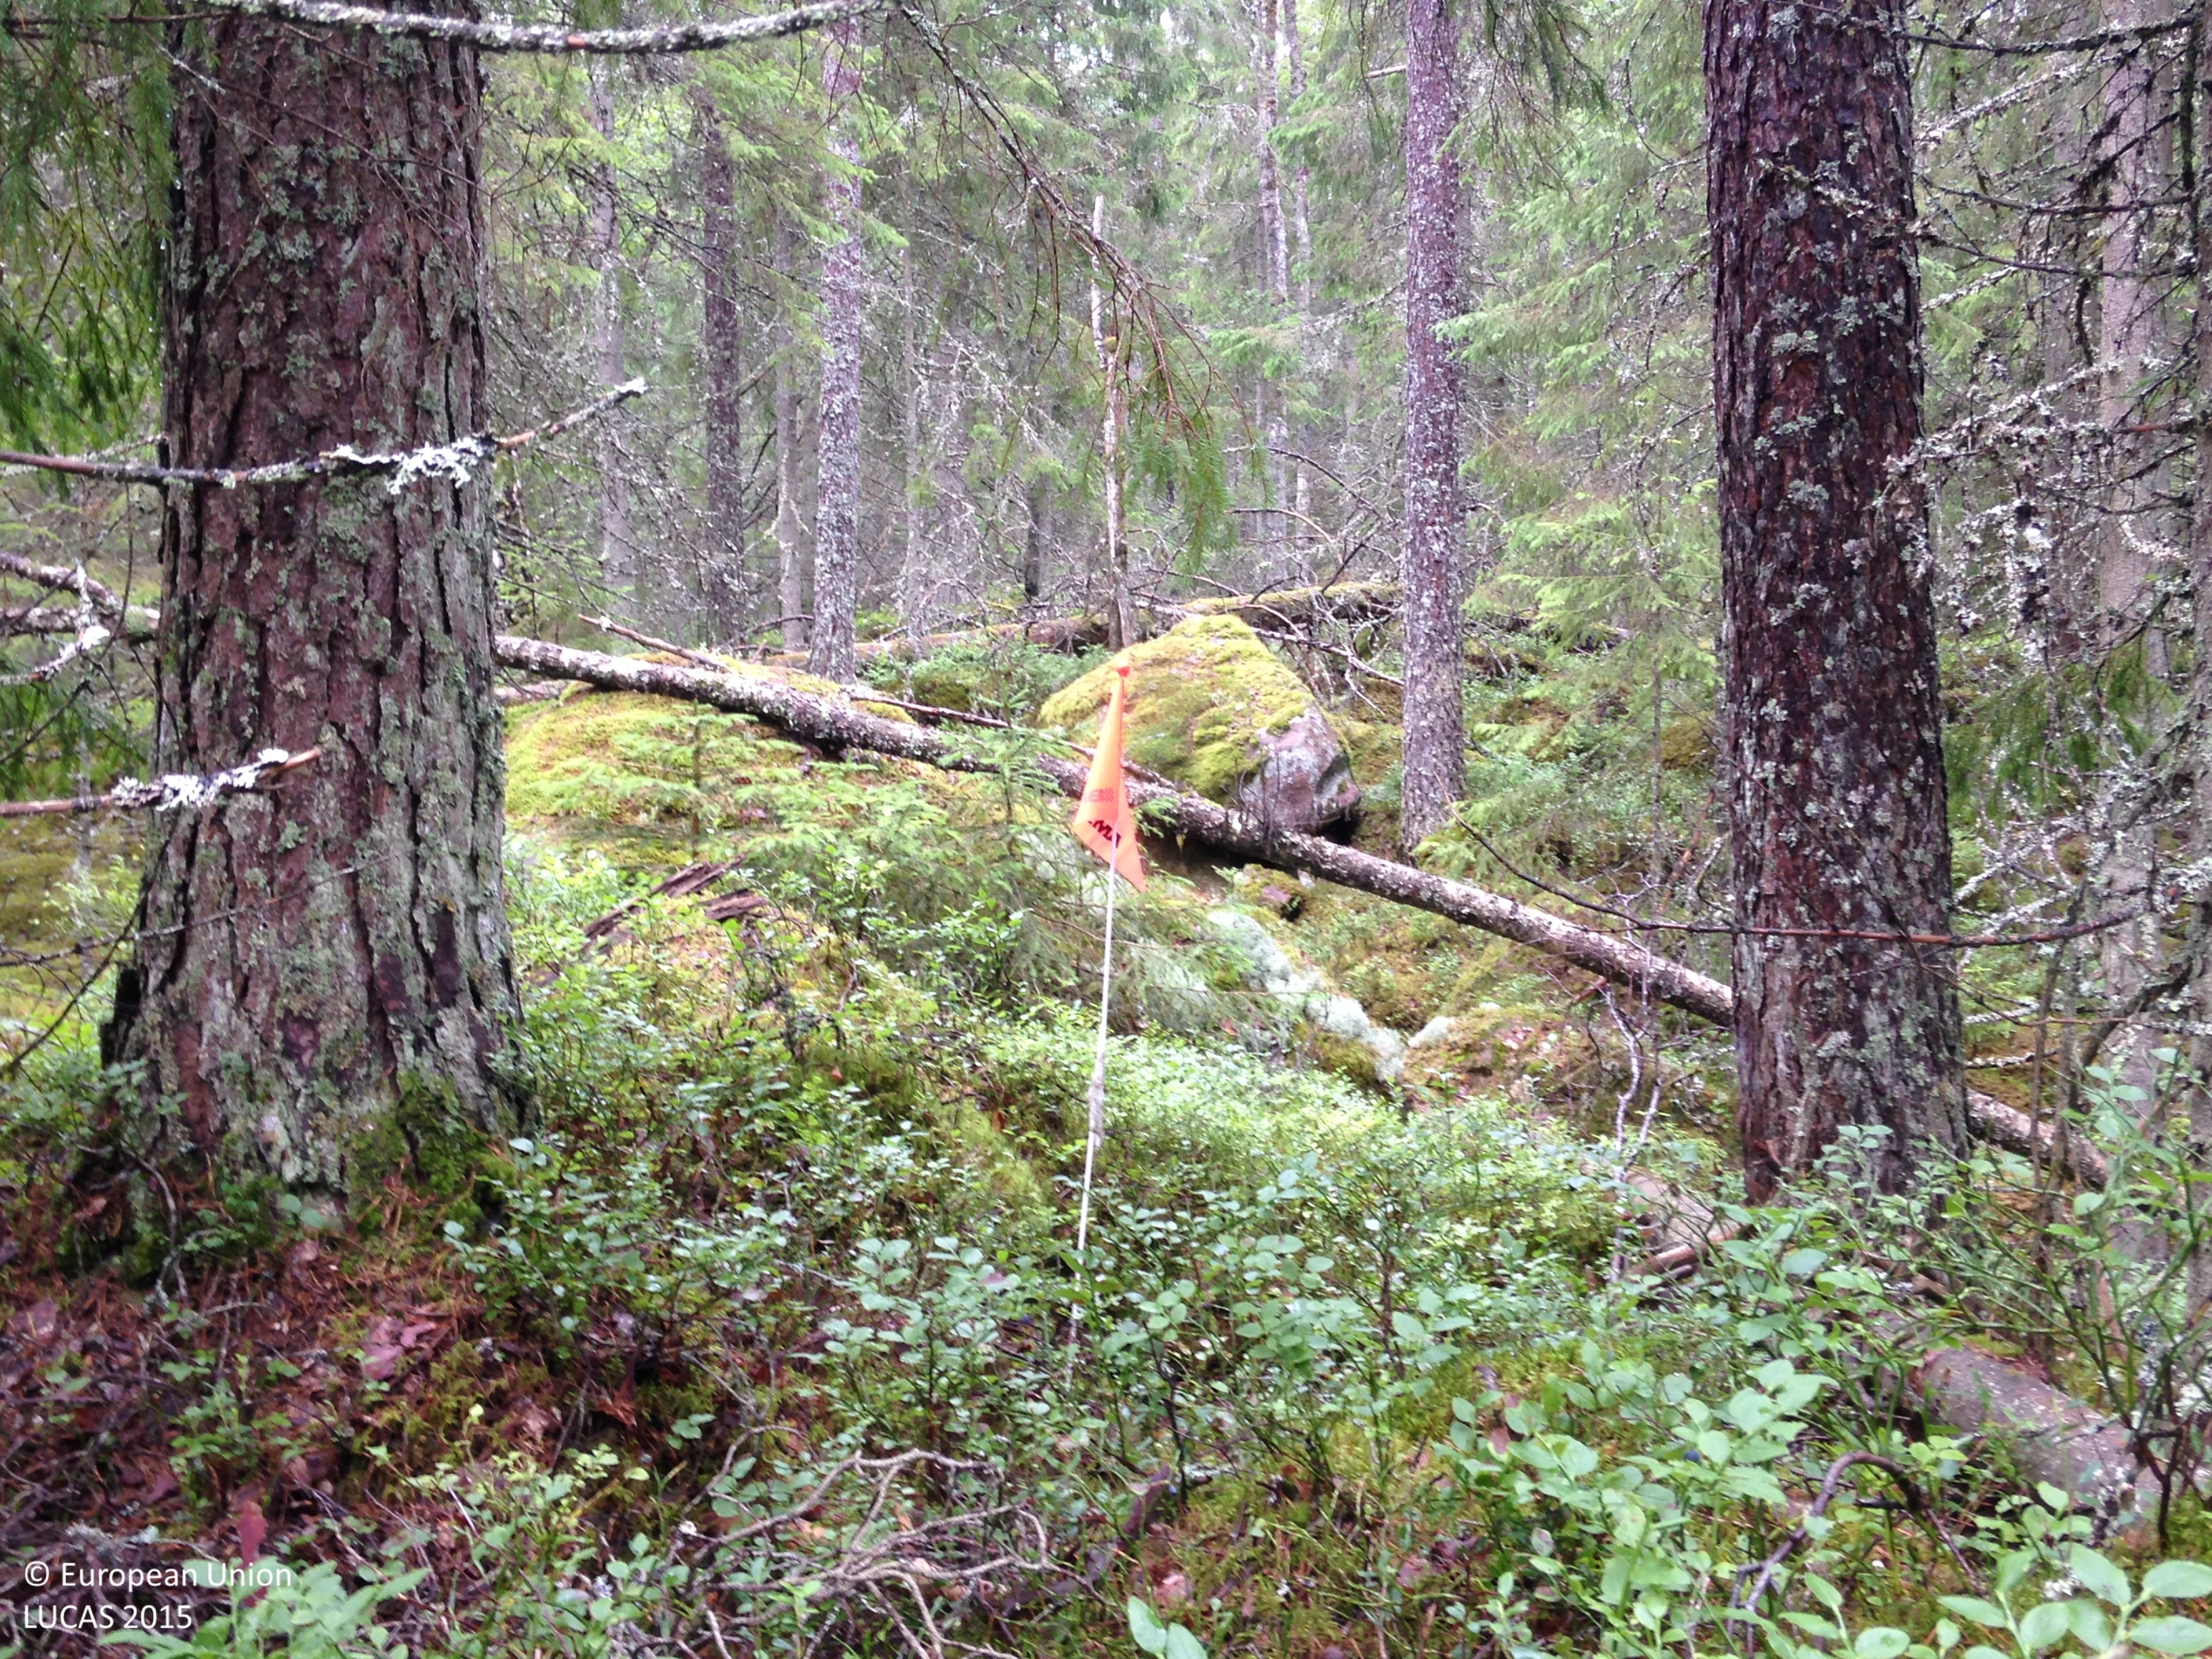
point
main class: Woodland
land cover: Other mixed woodland
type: boreal forest
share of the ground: 25 - 50 %
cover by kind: herbaceous plants 40 %, coniferous forest trees 25 %, lichens and mosses 20 %, broadleaved forest trees 15 %
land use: Amenities, museums, leisure
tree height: > 5 m
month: July
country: SE
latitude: 58.8824
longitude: 14.5205
